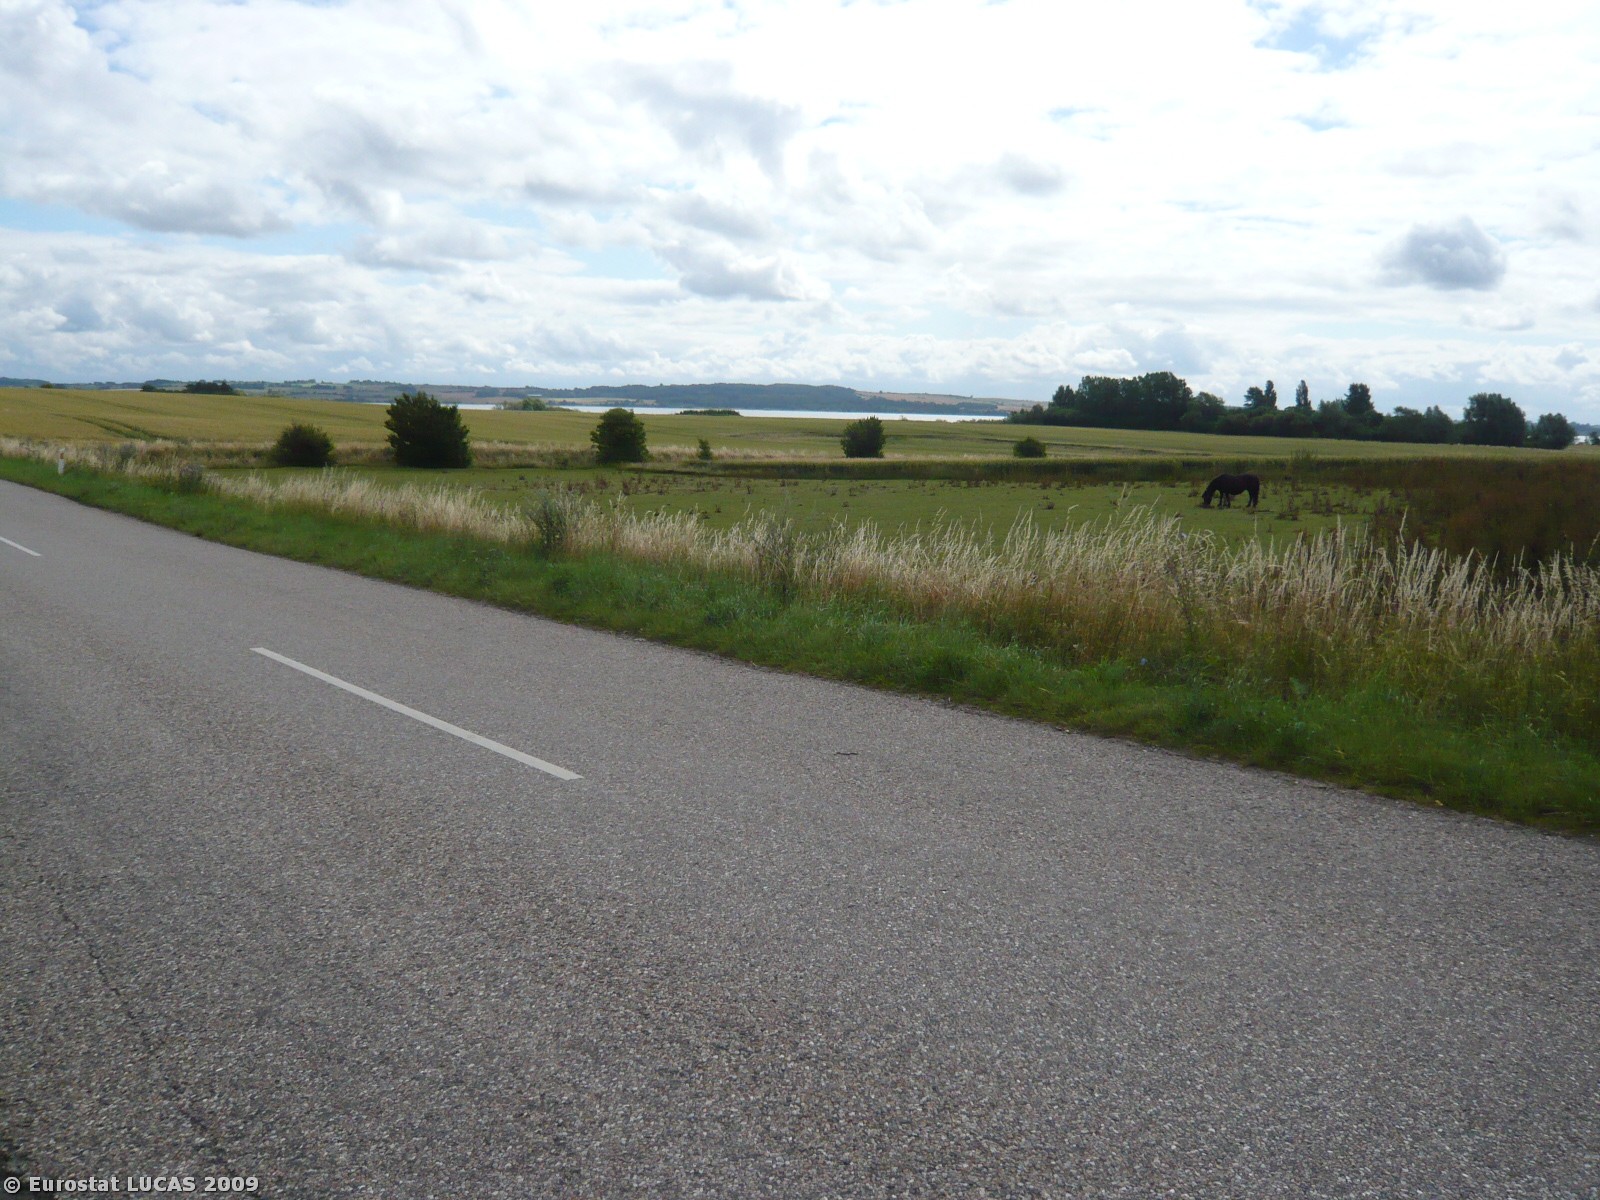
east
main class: Cropland
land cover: Common wheat
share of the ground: > 75 %
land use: Agriculture (excluding fallow land and kitchen gardens)
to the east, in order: Common wheat
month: July
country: DK
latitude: 55.5884
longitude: 11.2523
